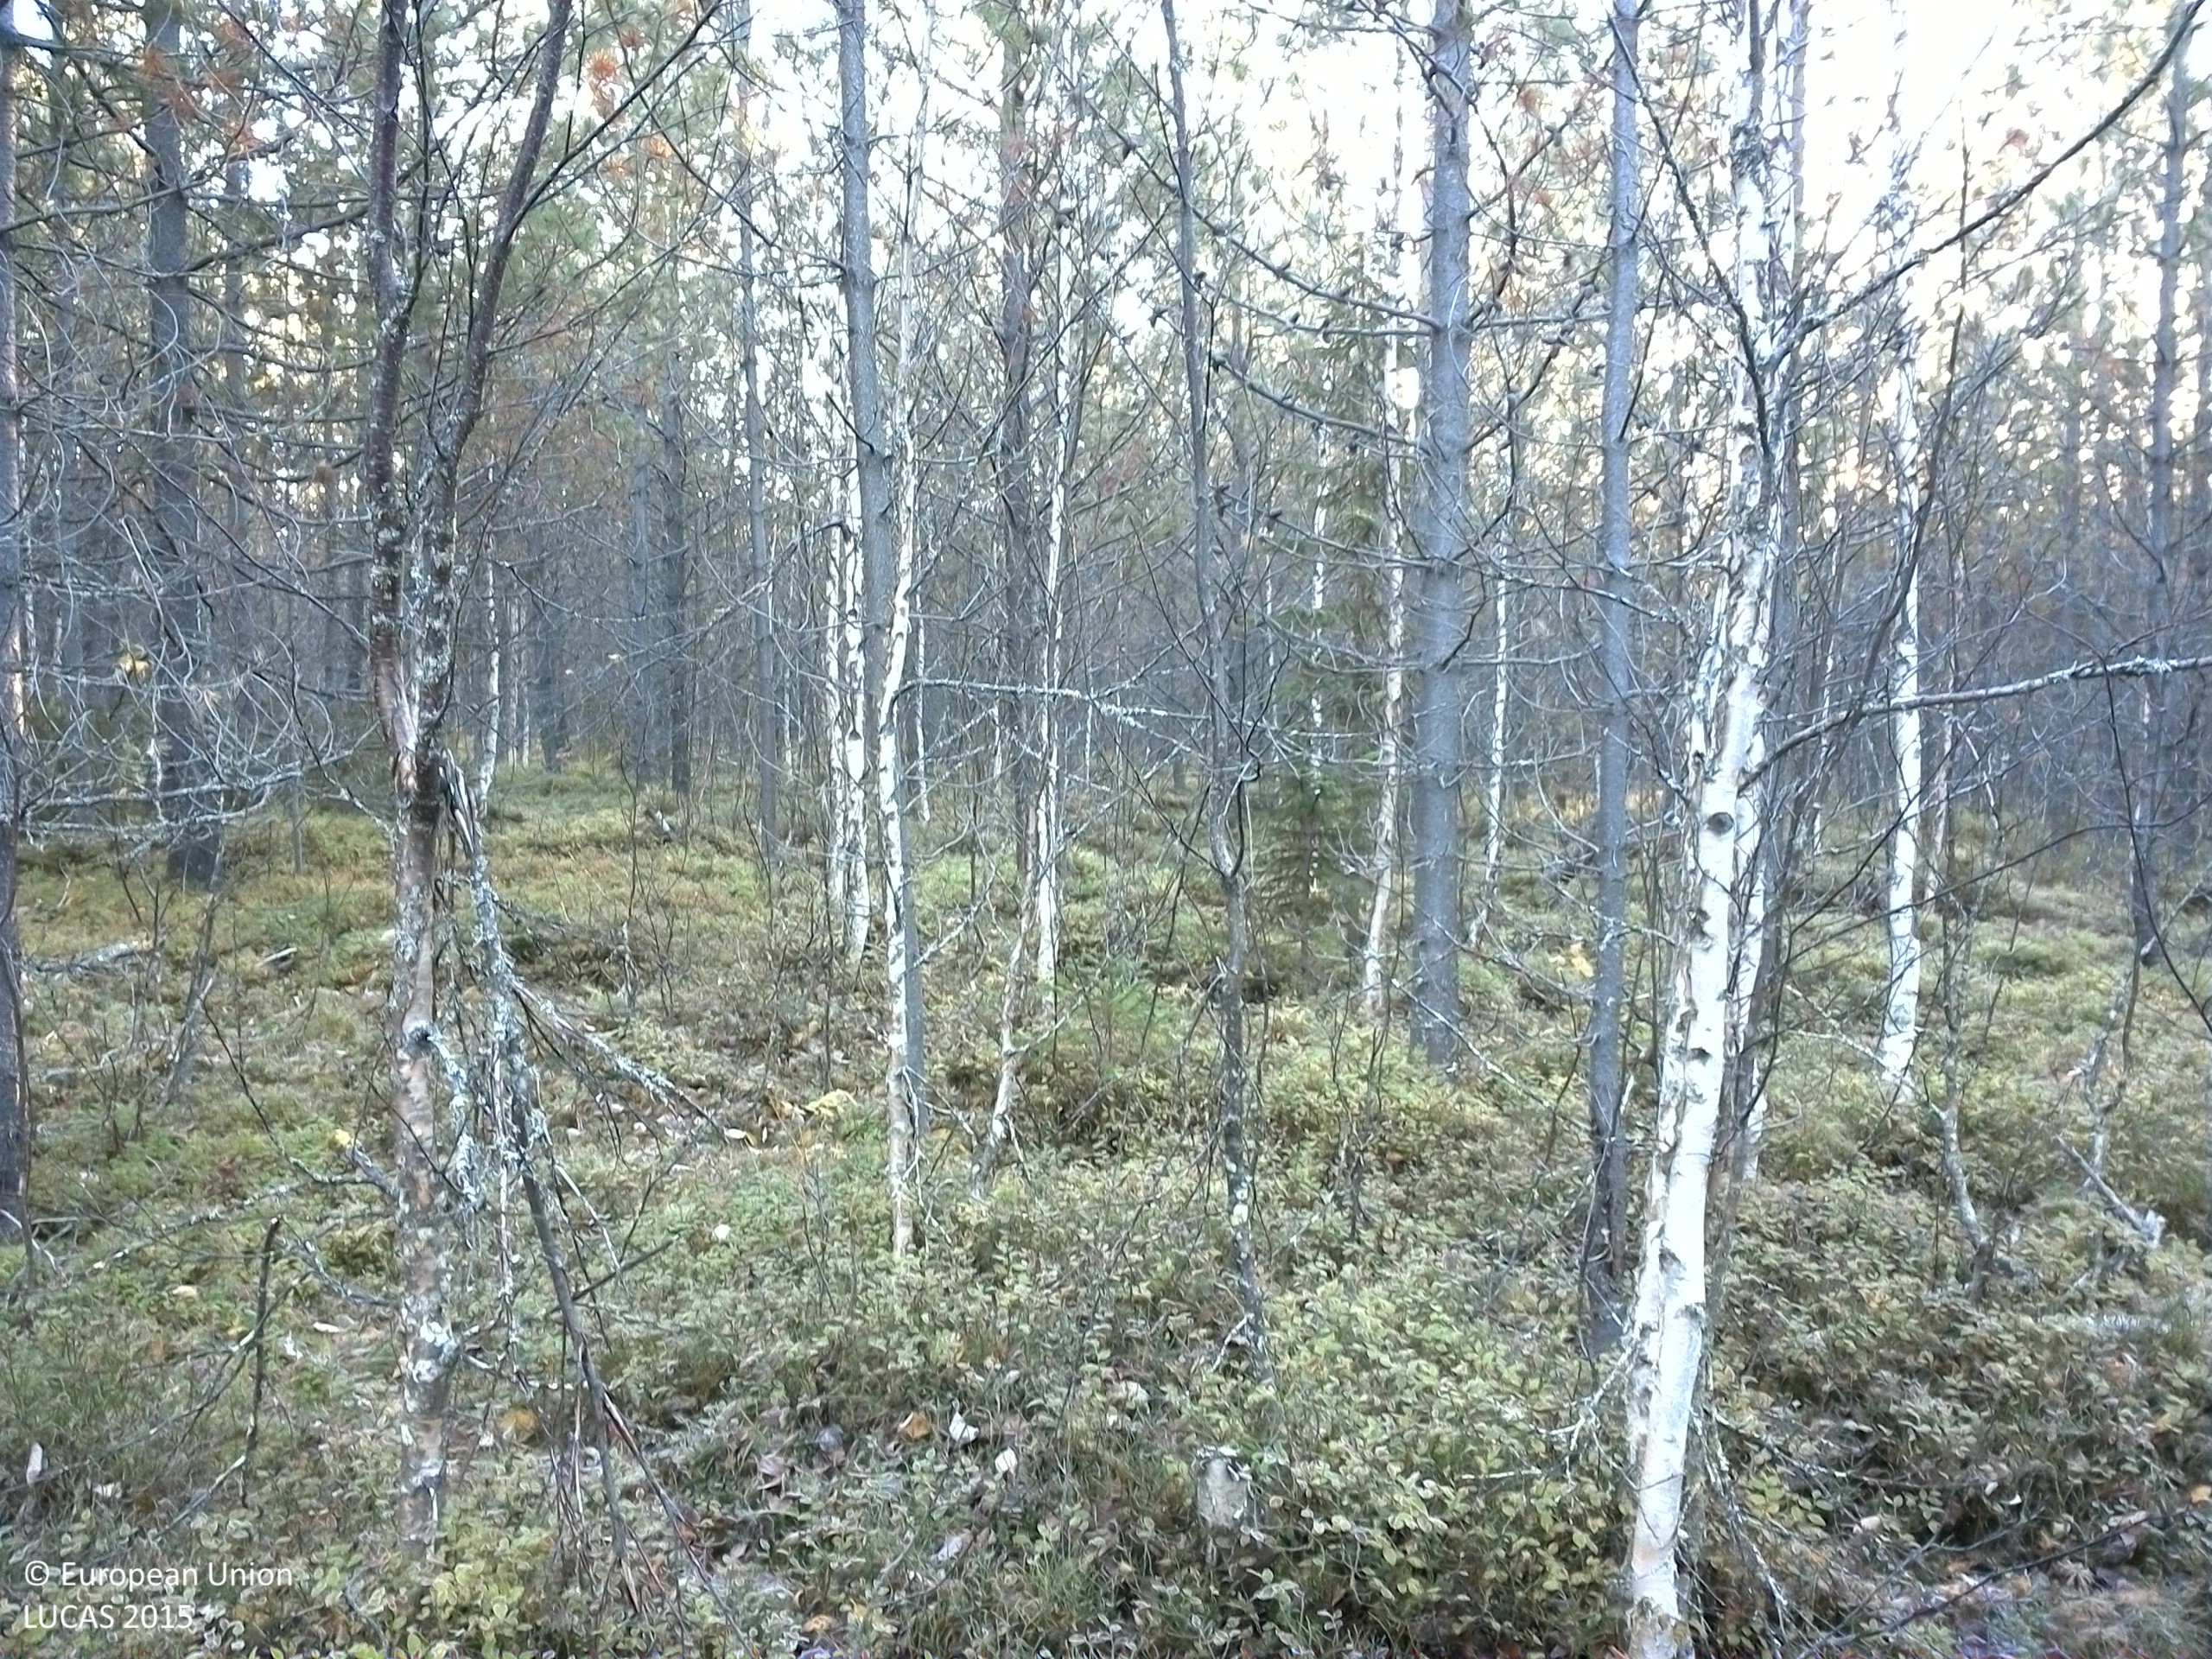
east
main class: Woodland
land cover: Pine dominated mixed woodland
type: exotic forest
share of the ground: 50 - 75 %
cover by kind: coniferous forest trees 40 %, shrubs 35 %, broadleaved forest trees 15 %, lichens and mosses 10 %
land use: Forestry
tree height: > 5 m
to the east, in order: Pine dominated mixed woodland; Pine dominated coniferous woodland
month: October
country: SE
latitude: 64.5549
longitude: 15.5394
